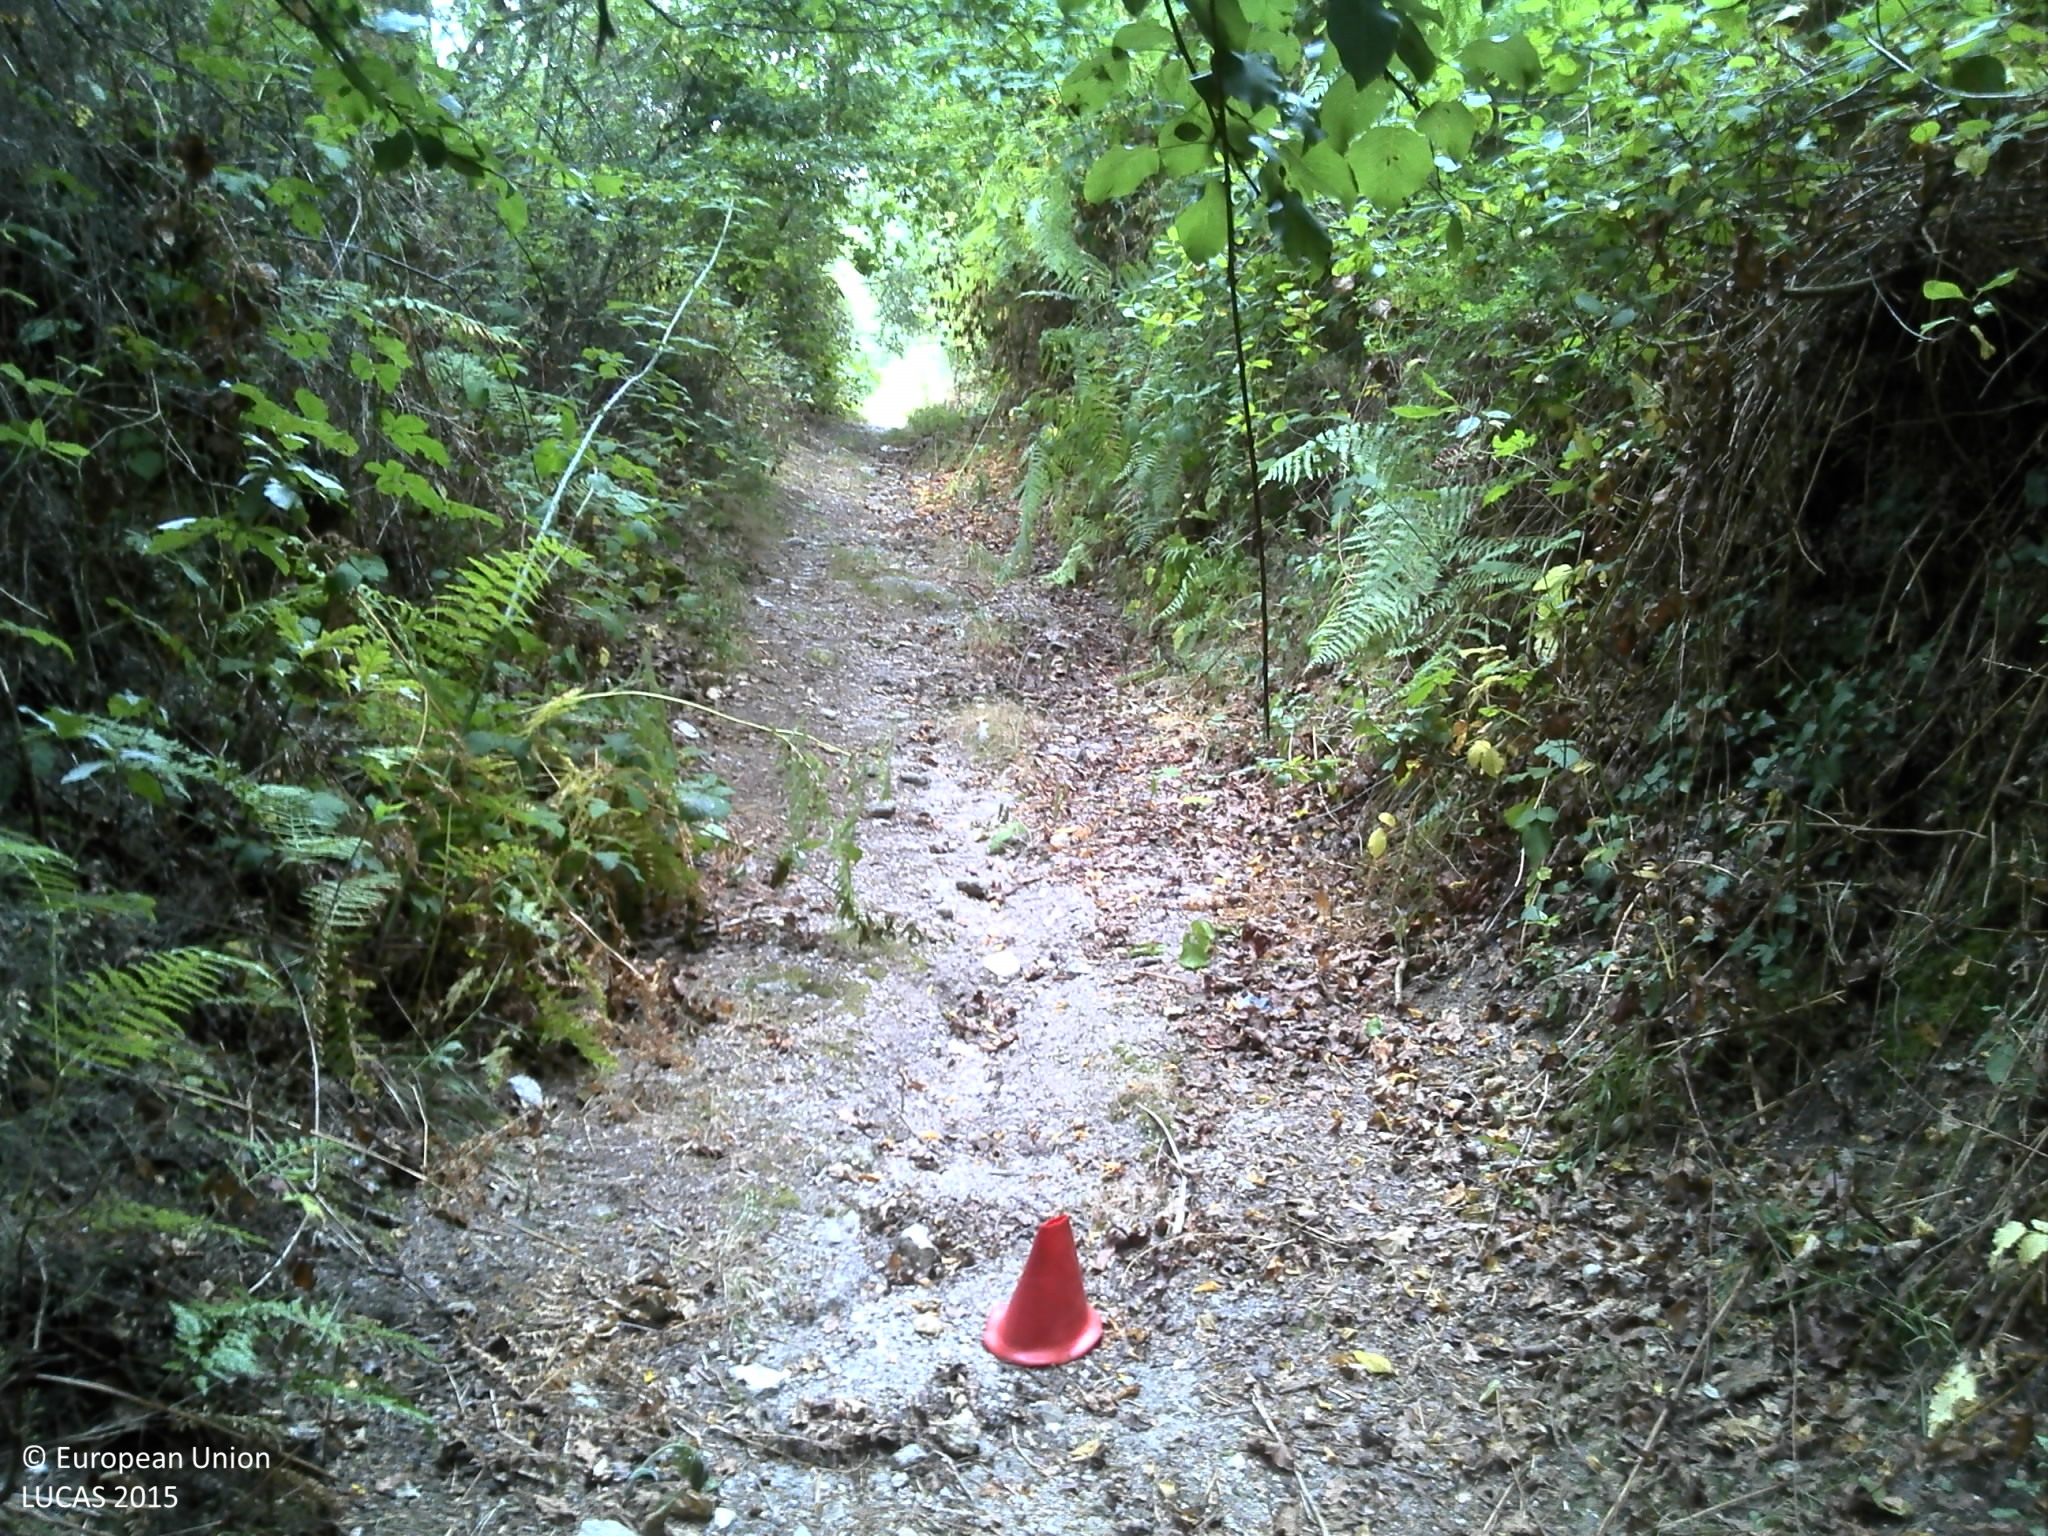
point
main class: Woodland
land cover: Broadleaved woodland
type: thermophilous deciduous forest
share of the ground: > 75 %
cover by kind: broadleaved forest trees 75 %, shrubs 15 %, consolidated bare surface 5 %, unconsolidated bare surface 5 %
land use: Semi-natural and natural areas not in use
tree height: > 5 m
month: July
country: PT
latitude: 41.5445
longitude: -8.0896
